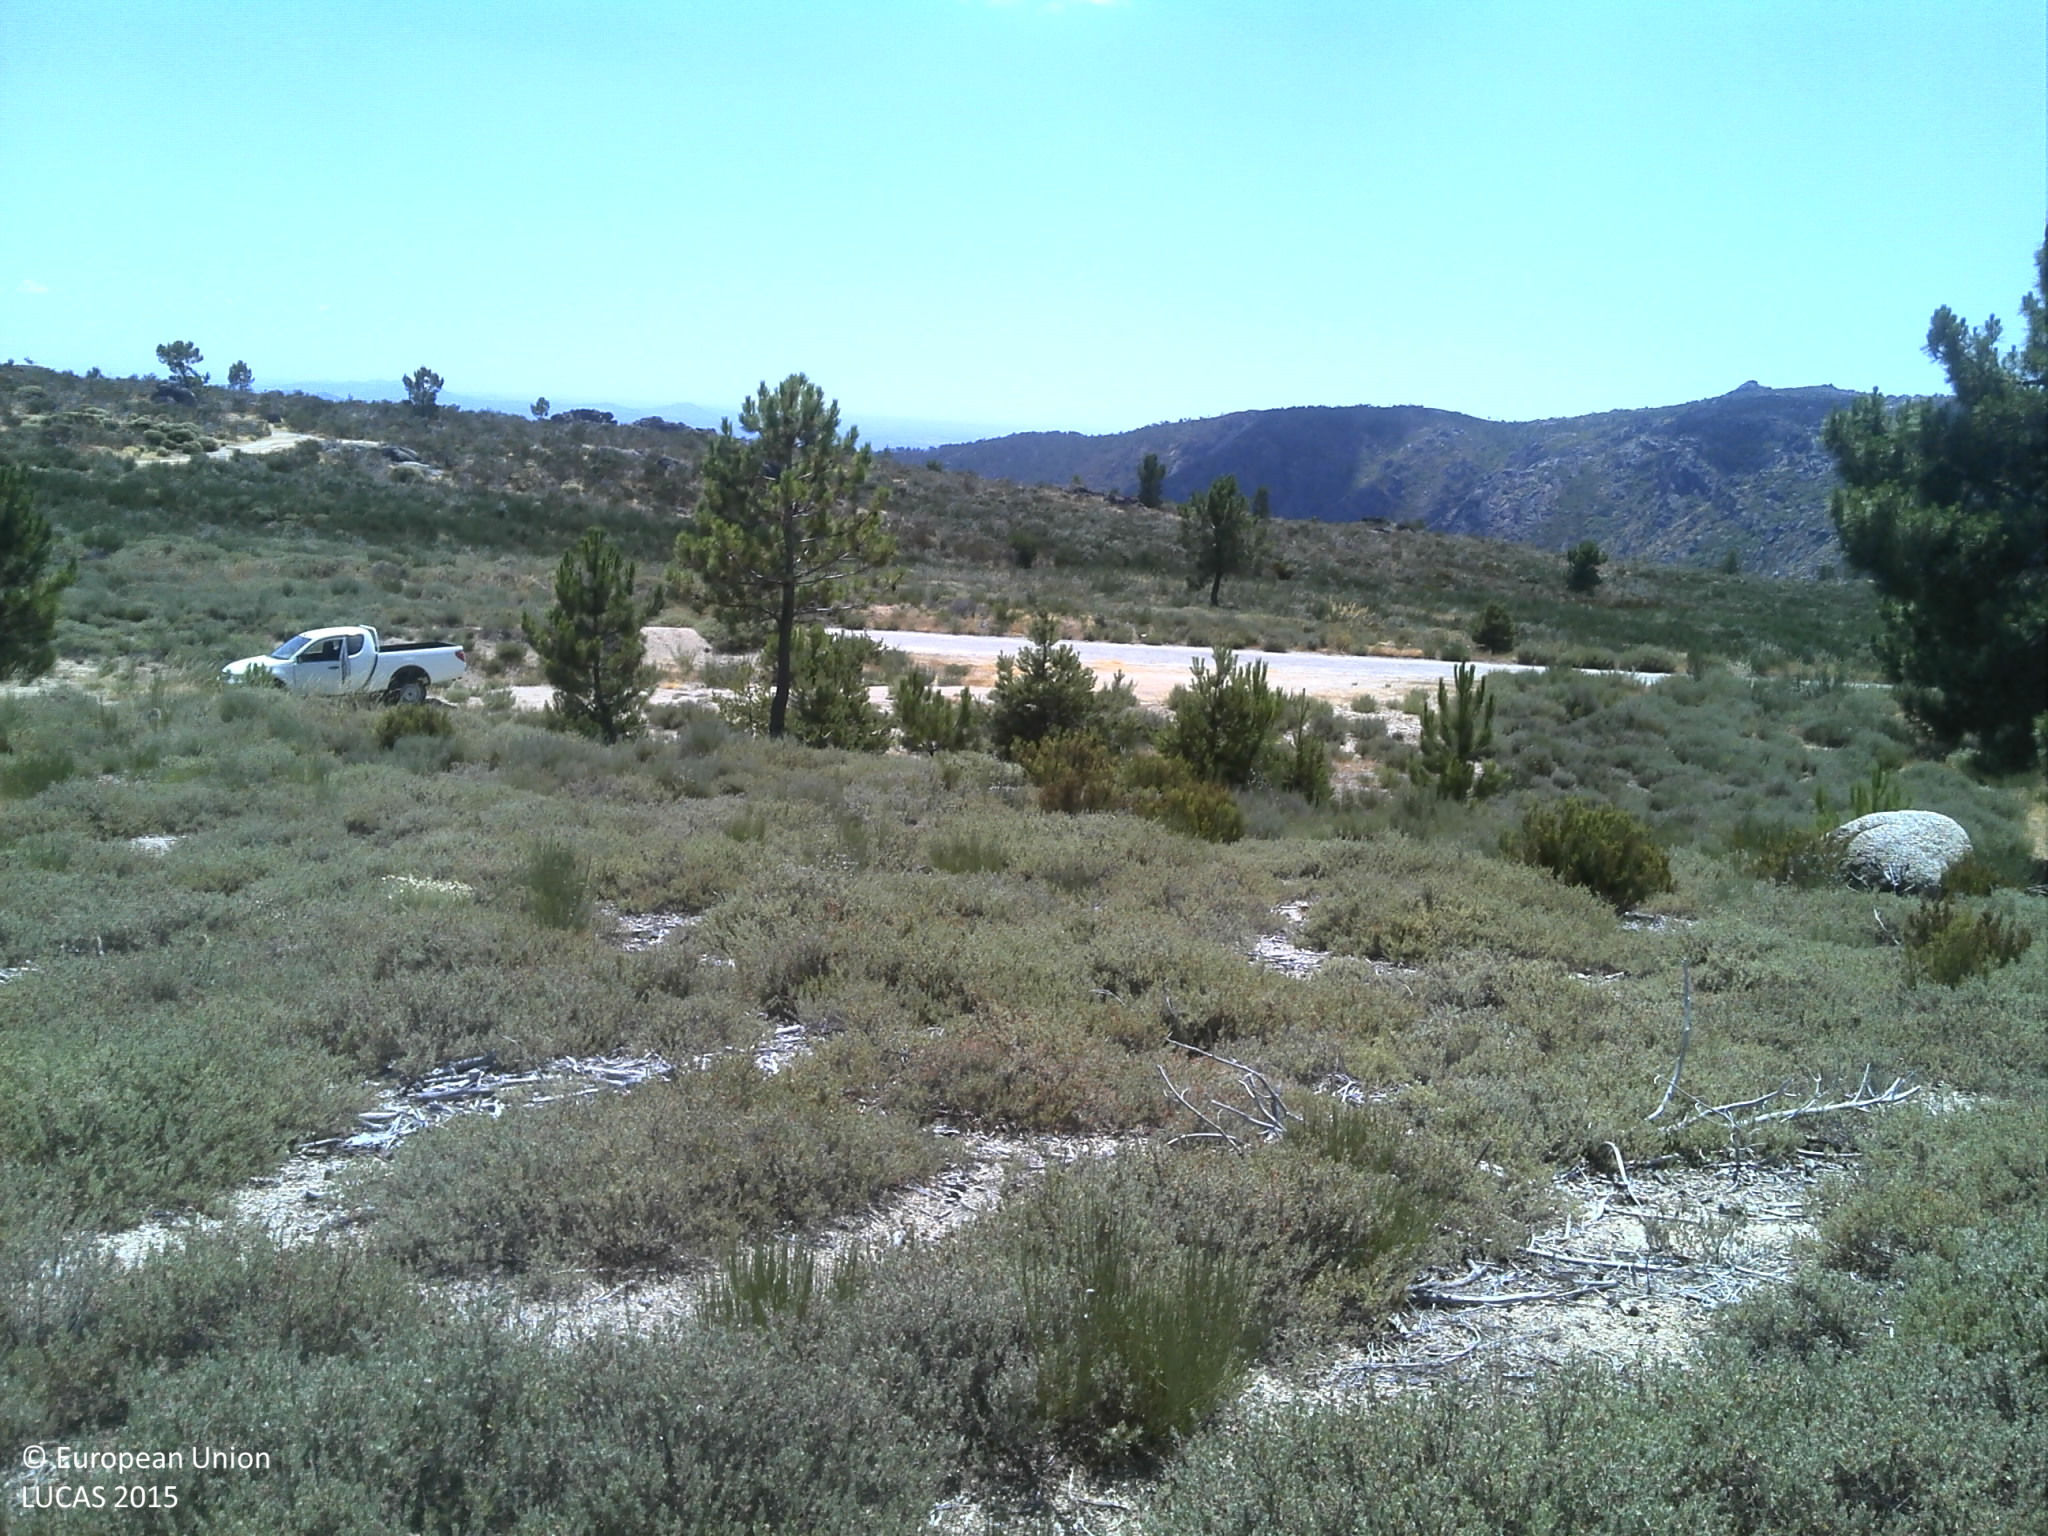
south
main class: Shrubland
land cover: Shrubland without tree cover
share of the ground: > 75 %
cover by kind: shrubs 75 %, consolidated bare surface 20 %, herbaceous plants 5 %
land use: Semi-natural and natural areas not in use
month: July
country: PT
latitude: 40.3559
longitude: -7.5238
